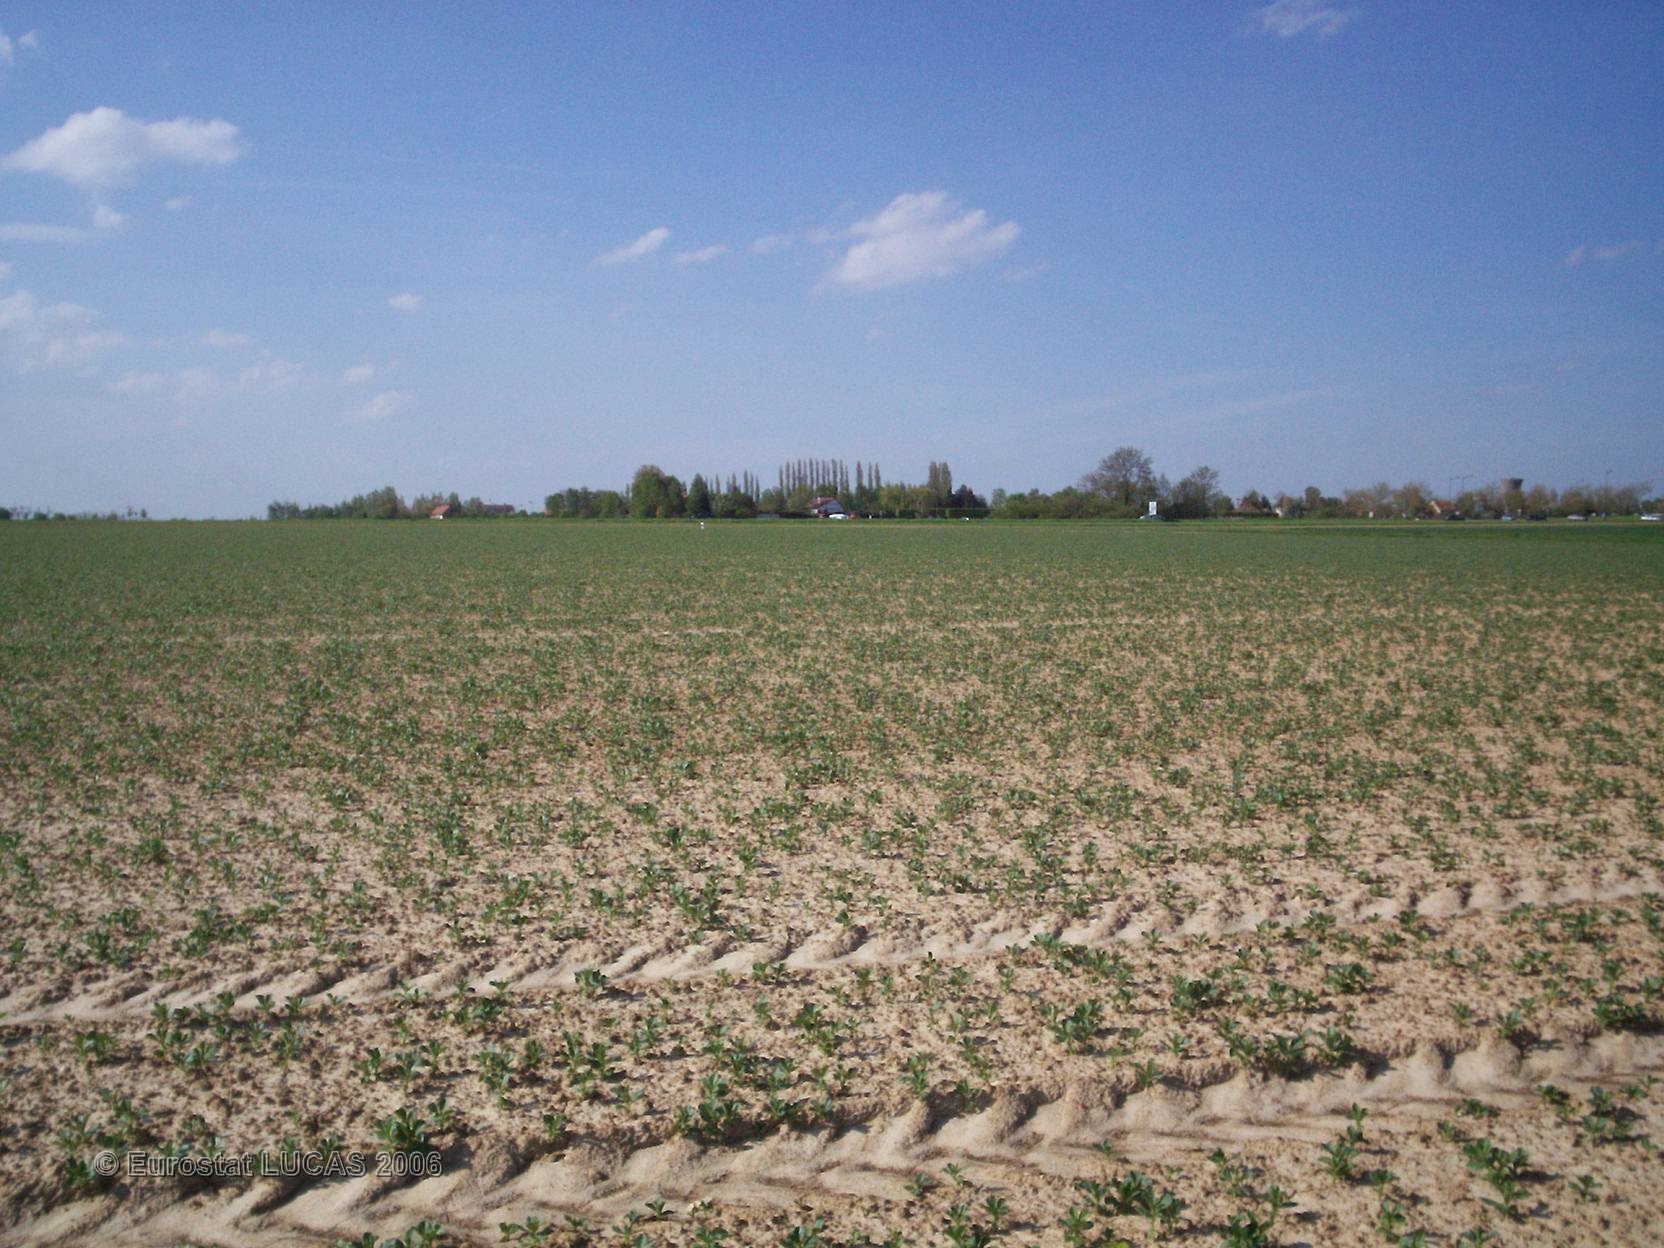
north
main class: Cropland
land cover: Sugar beet
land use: Agriculture (excluding fallow land and kitchen gardens)
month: May
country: FR
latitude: 48.8359
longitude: 2.7832
